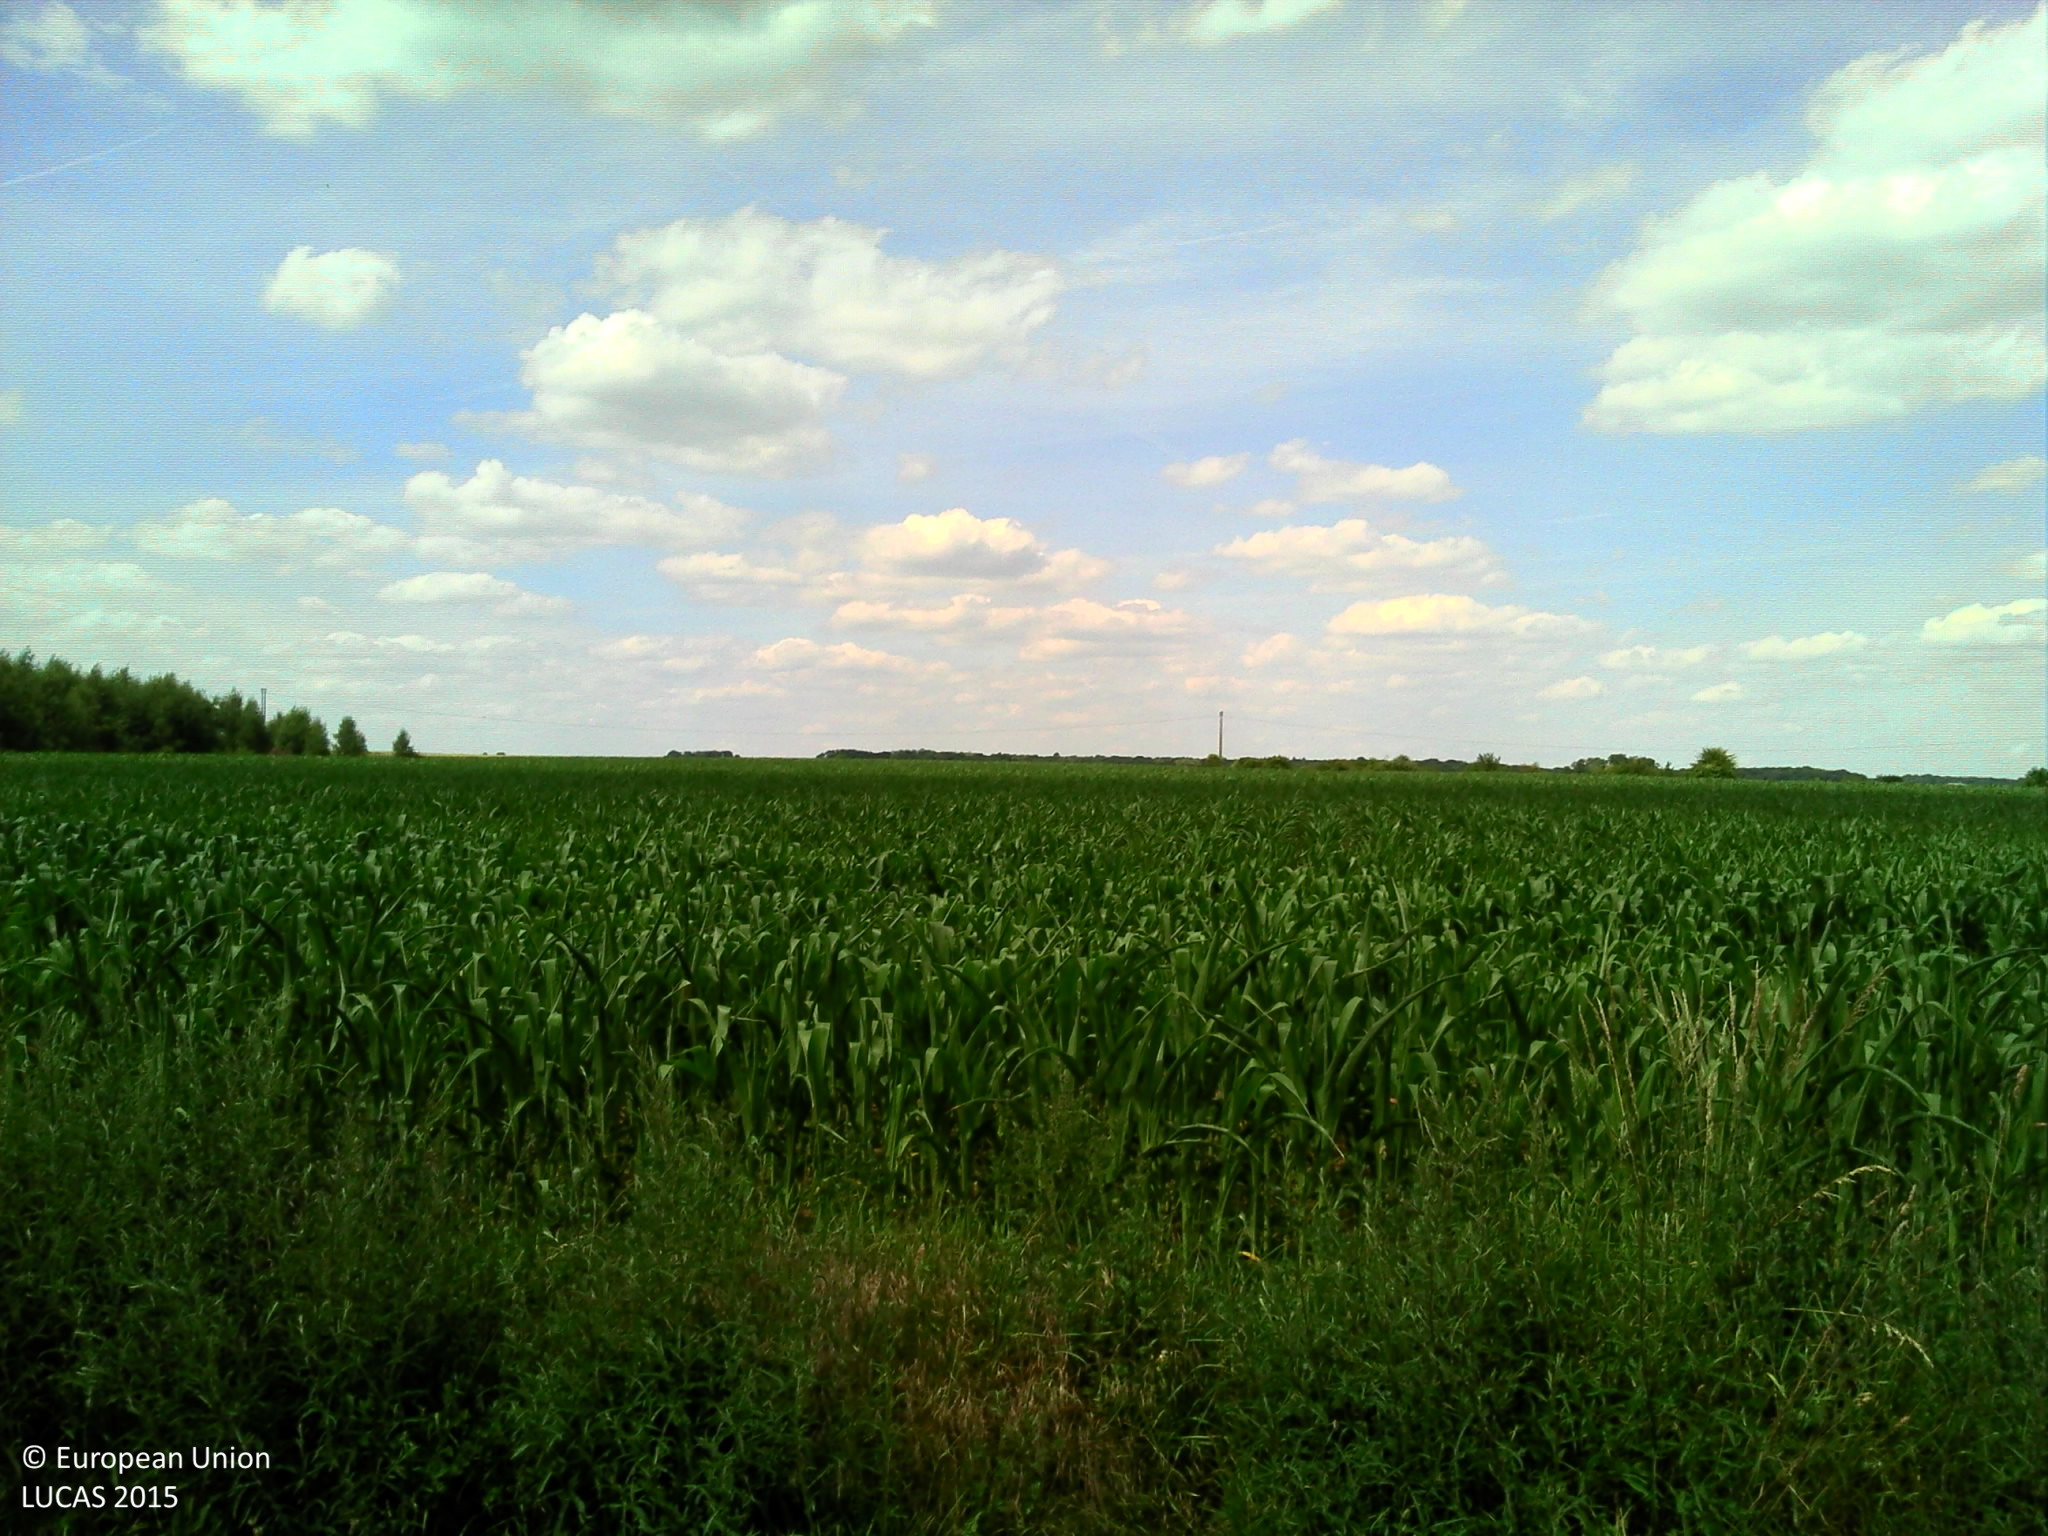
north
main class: Cropland
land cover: Maize
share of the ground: > 75 %
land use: Agriculture (excluding fallow land and kitchen gardens)
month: June
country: FR
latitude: 49.3617
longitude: 2.5393
